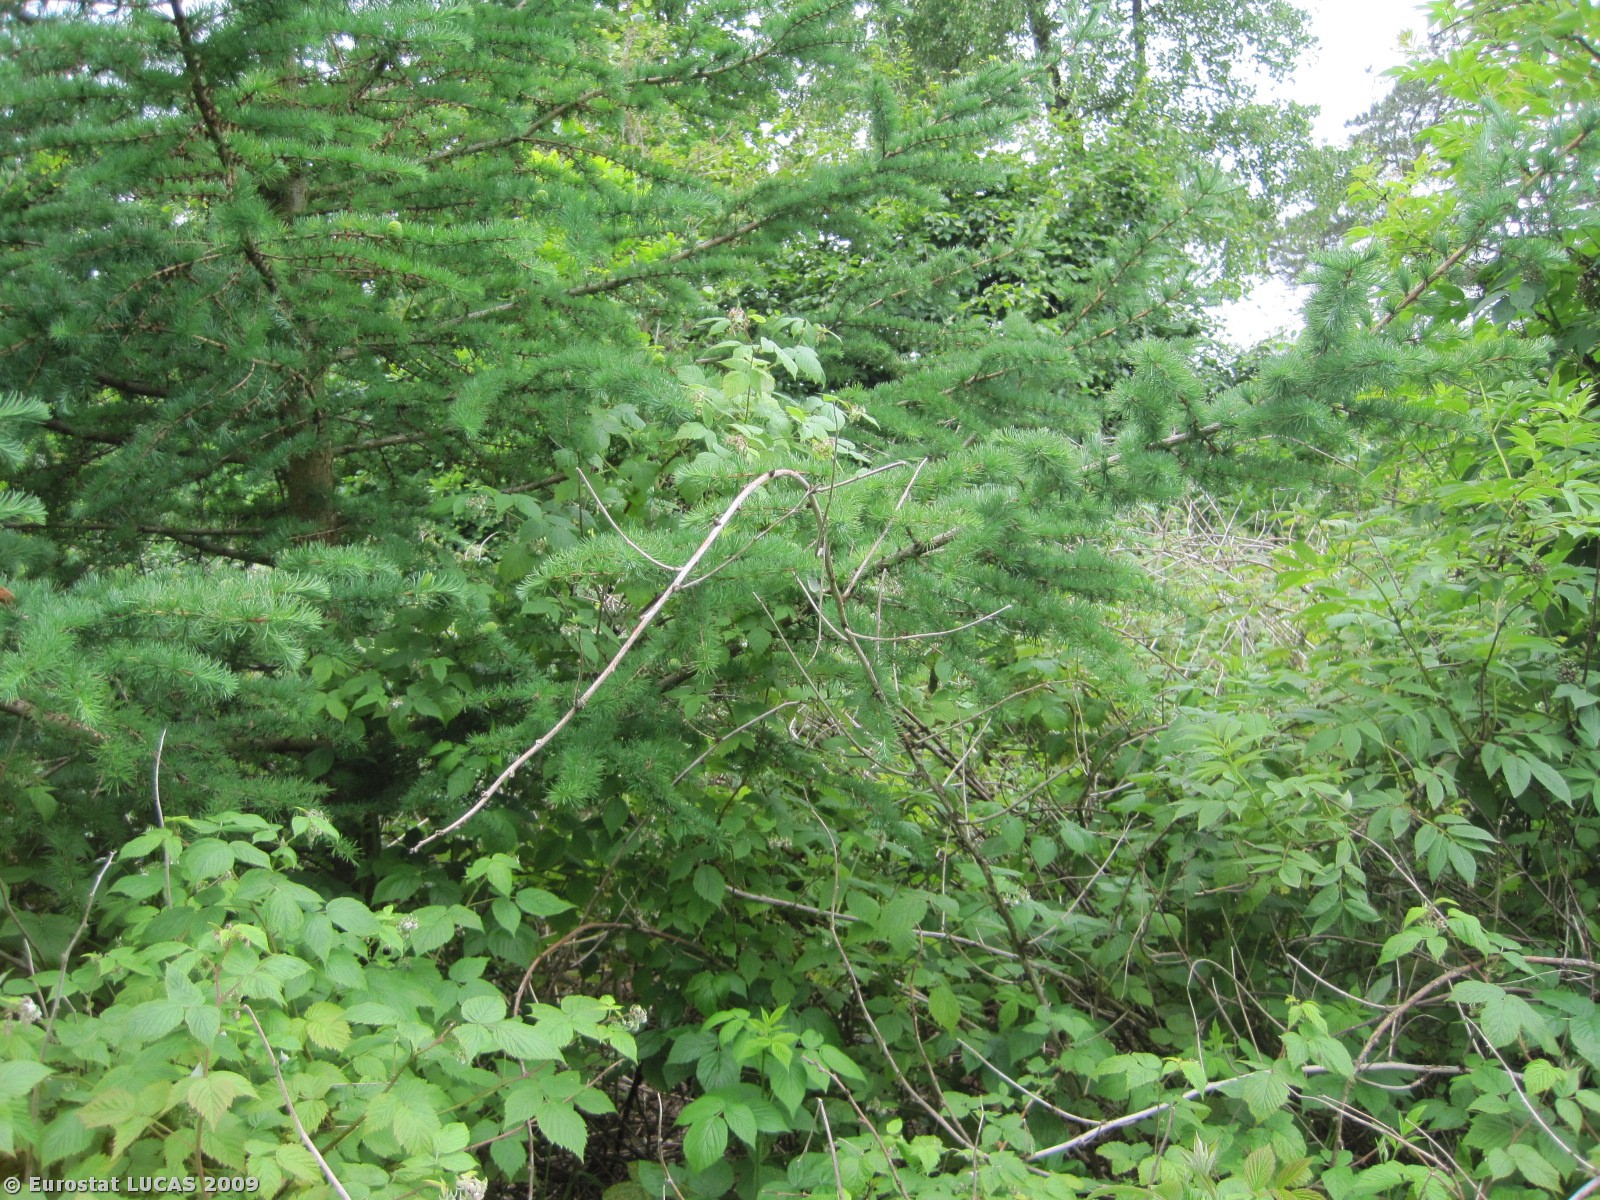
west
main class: Shrubland
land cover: Shrubland with sparse tree cover
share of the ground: > 75 %
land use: Unused
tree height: < 5 m
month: June
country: DK
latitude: 57.3563
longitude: 10.0166
